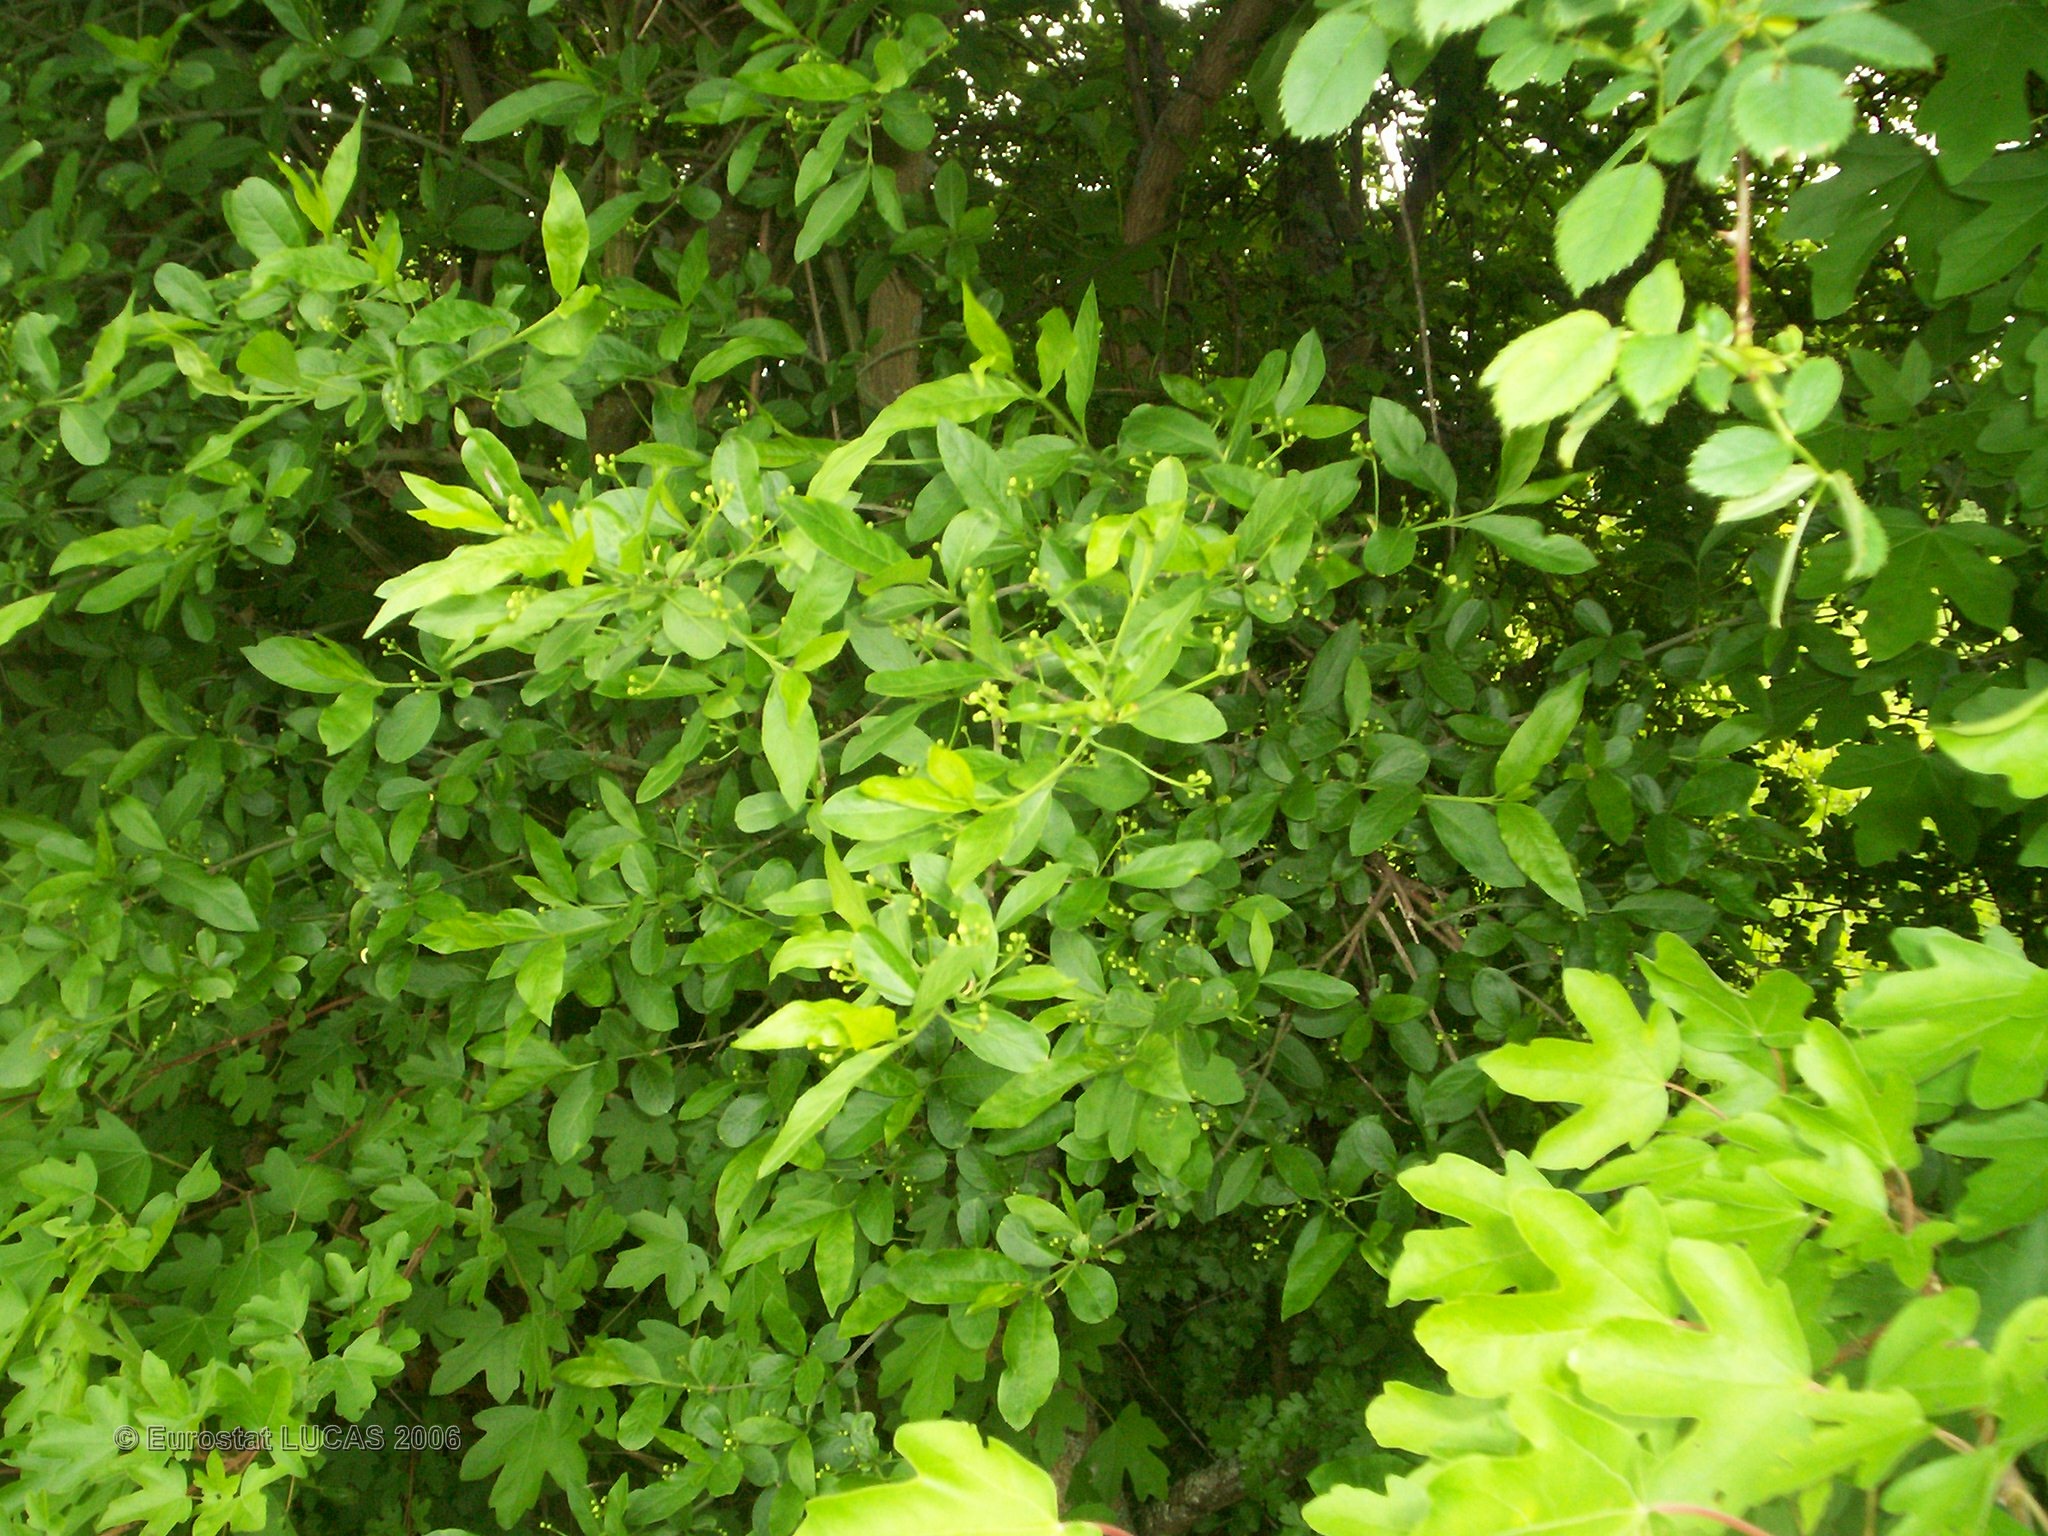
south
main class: Grassland
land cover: Grassland without tree/shrub cover
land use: Agriculture (excluding fallow land and kitchen gardens)
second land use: Sport
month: May
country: FR
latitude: 47.6921
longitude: 2.9720
